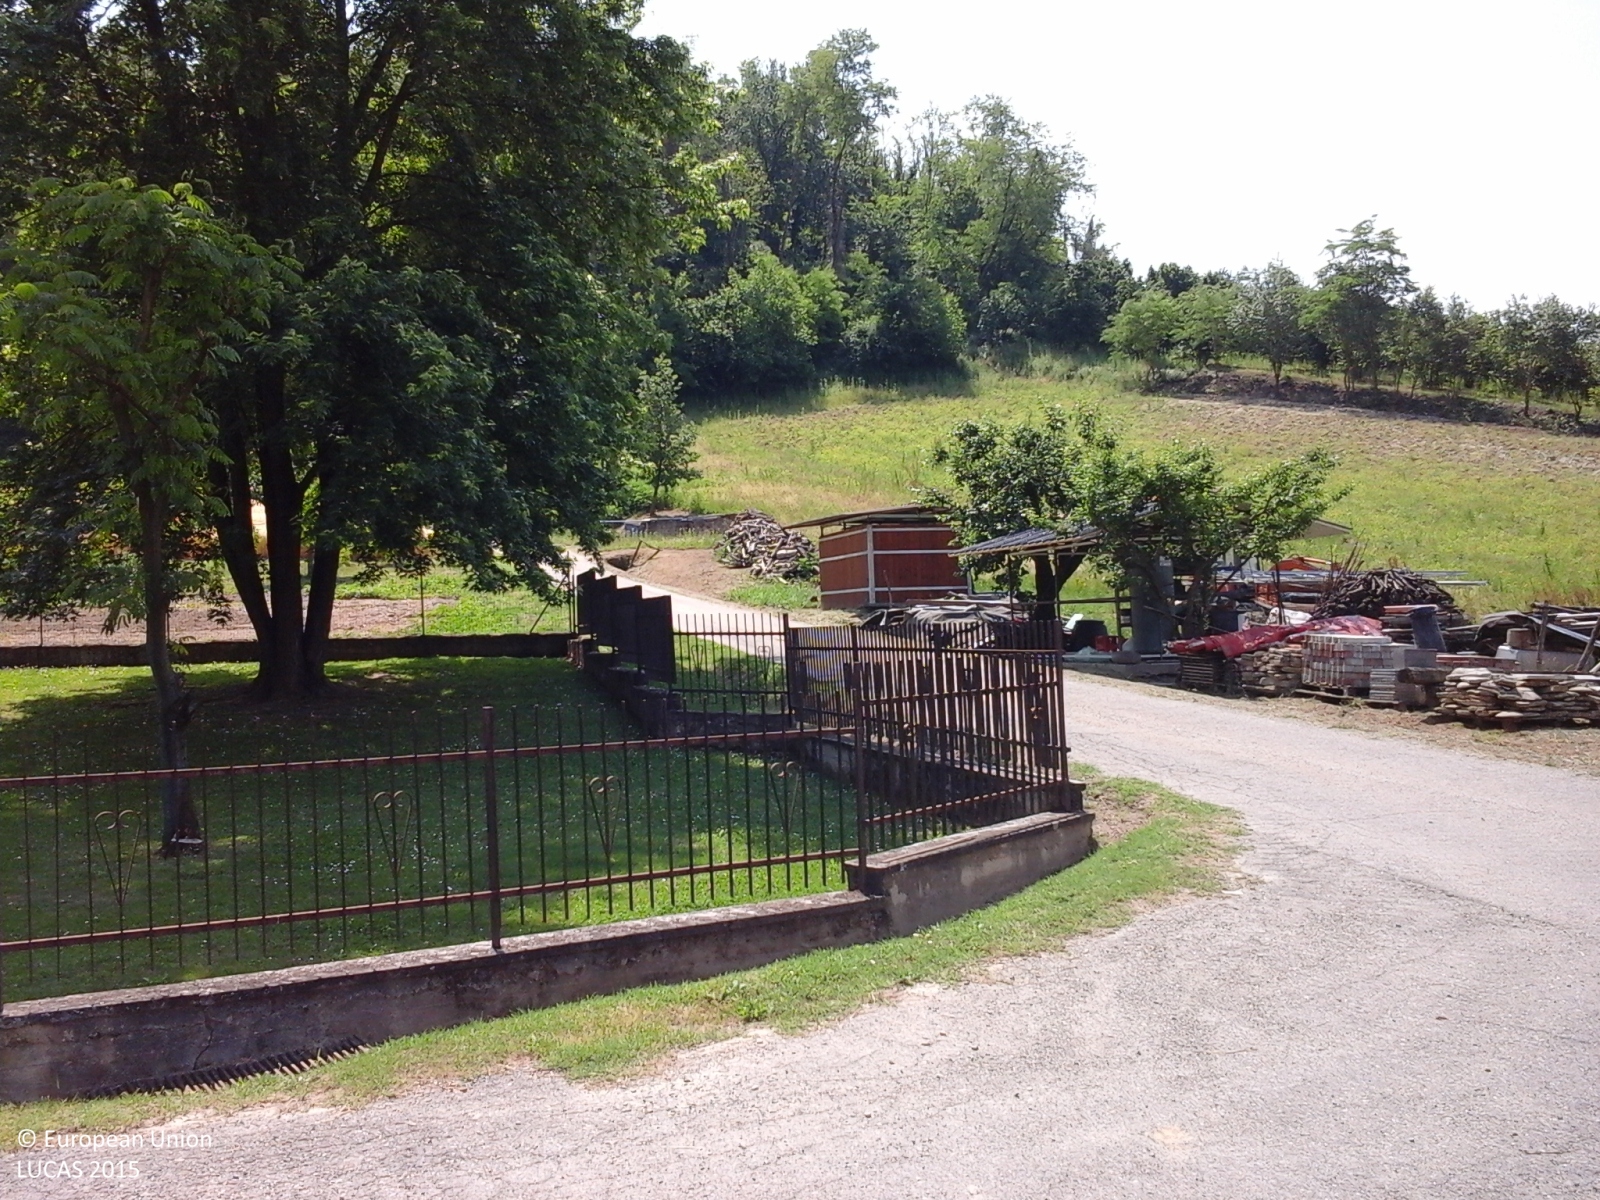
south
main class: Woodland
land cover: Other mixed woodland
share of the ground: 50 - 75 %
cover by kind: coniferous forest trees 50 %, herbaceous plants 30 %, broadleaved forest trees 20 %
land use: Residential
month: May
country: IT
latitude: 44.7338
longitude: 8.3239
